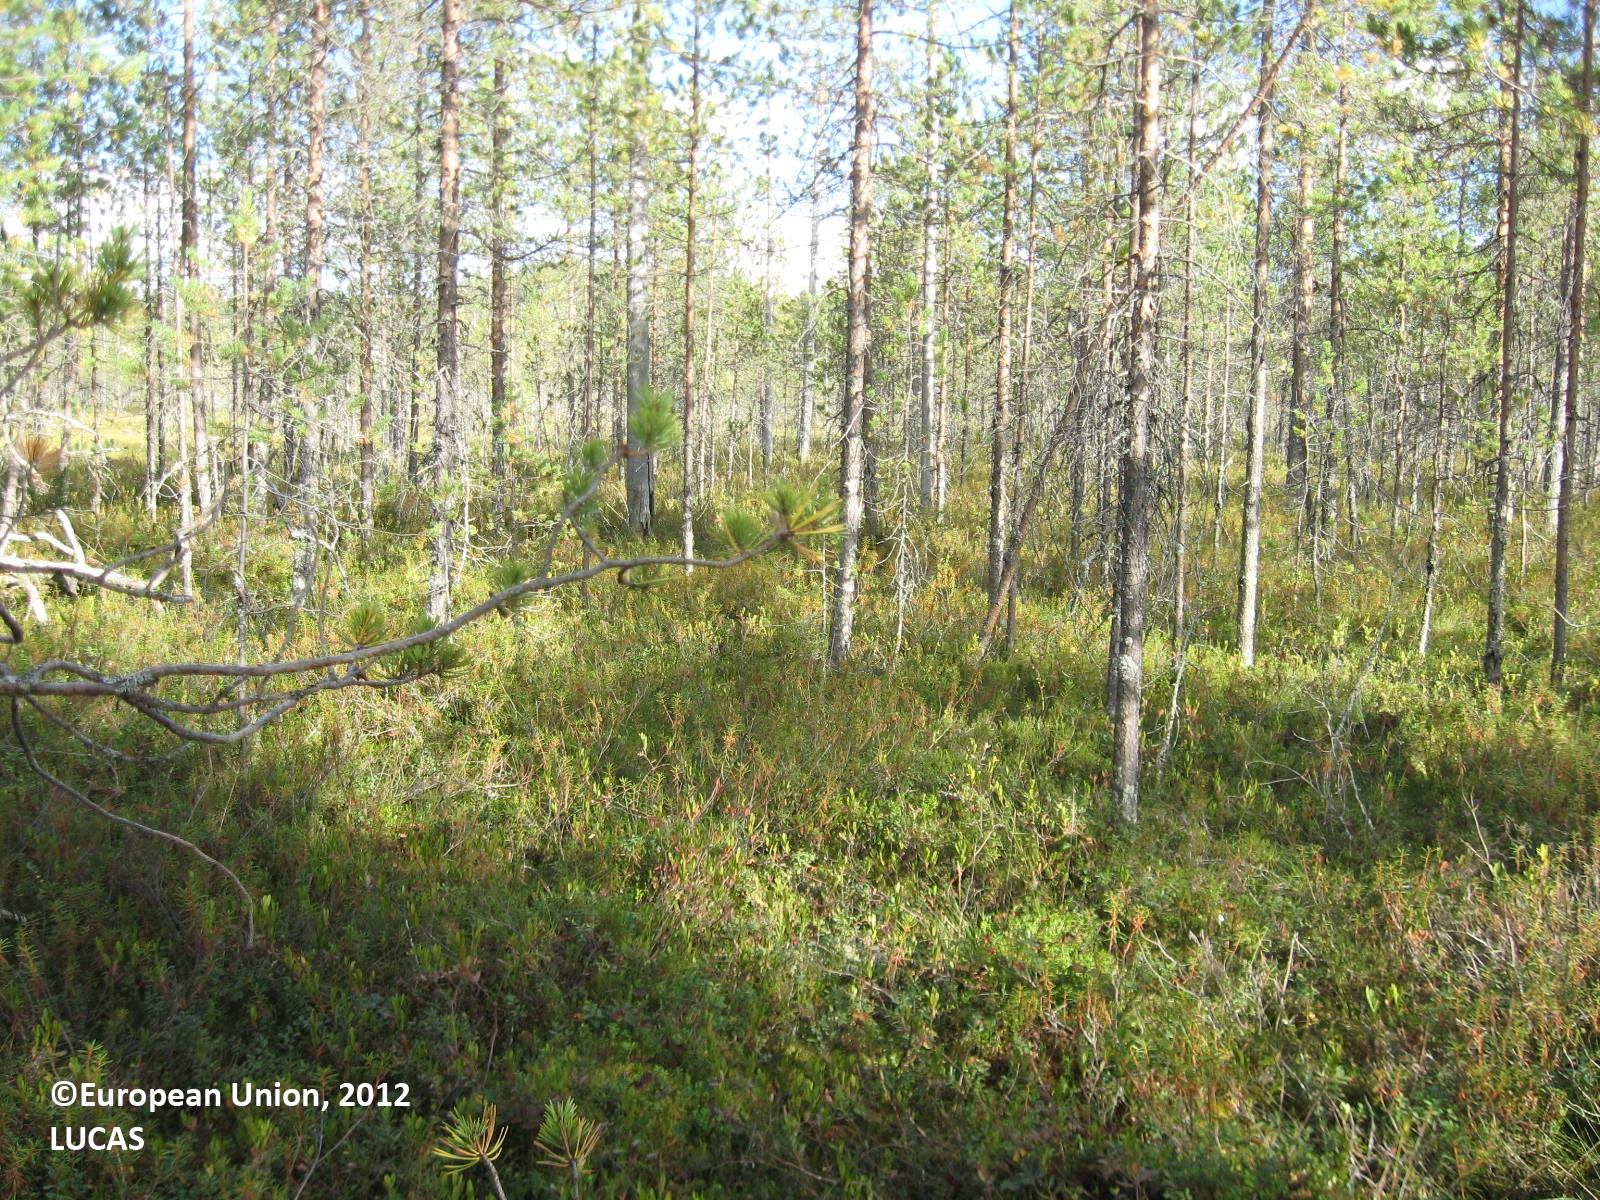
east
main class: Woodland
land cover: Pine dominated coniferous woodland
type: boreal forest
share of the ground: 50 - 75 %
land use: Semi-natural and natural areas not in use
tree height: > 5 m
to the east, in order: Pine dominated coniferous woodland; Peatbogs
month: August
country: FI
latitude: 63.8402
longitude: 29.2201
